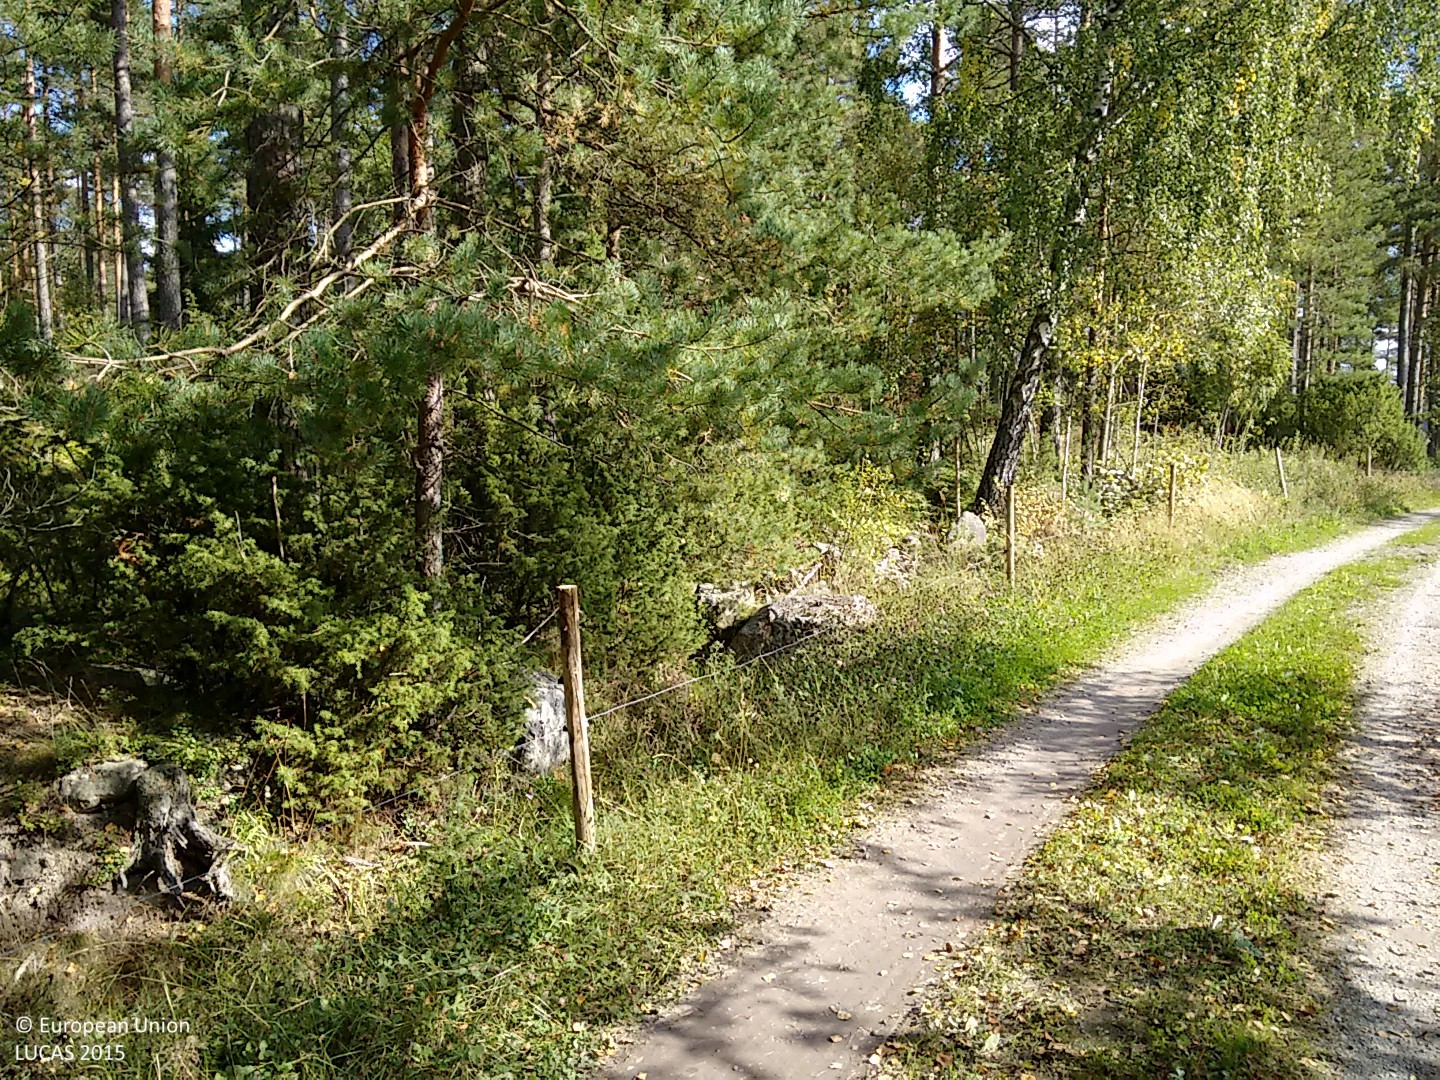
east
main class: Woodland
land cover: Pine dominated coniferous woodland
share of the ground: > 75 %
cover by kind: coniferous forest trees 80 %, unconsolidated bare surface 15 %, broadleaved forest trees 5 %
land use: Agriculture (excluding fallow land and kitchen gardens)
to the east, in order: Pine dominated coniferous woodland; Grassland without tree/shrub cover; Dry stone walls; Grassland without tree/shrub cover; Fences; Grass margins; Tracks; Fences; Pine dominated coniferous woodland; Electric lines; Pine dominated coniferous woodland; Grassland without tree/shrub cover; Fences; Grassland without tree/shrub cover
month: September
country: FI
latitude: 60.9702
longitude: 21.6759
